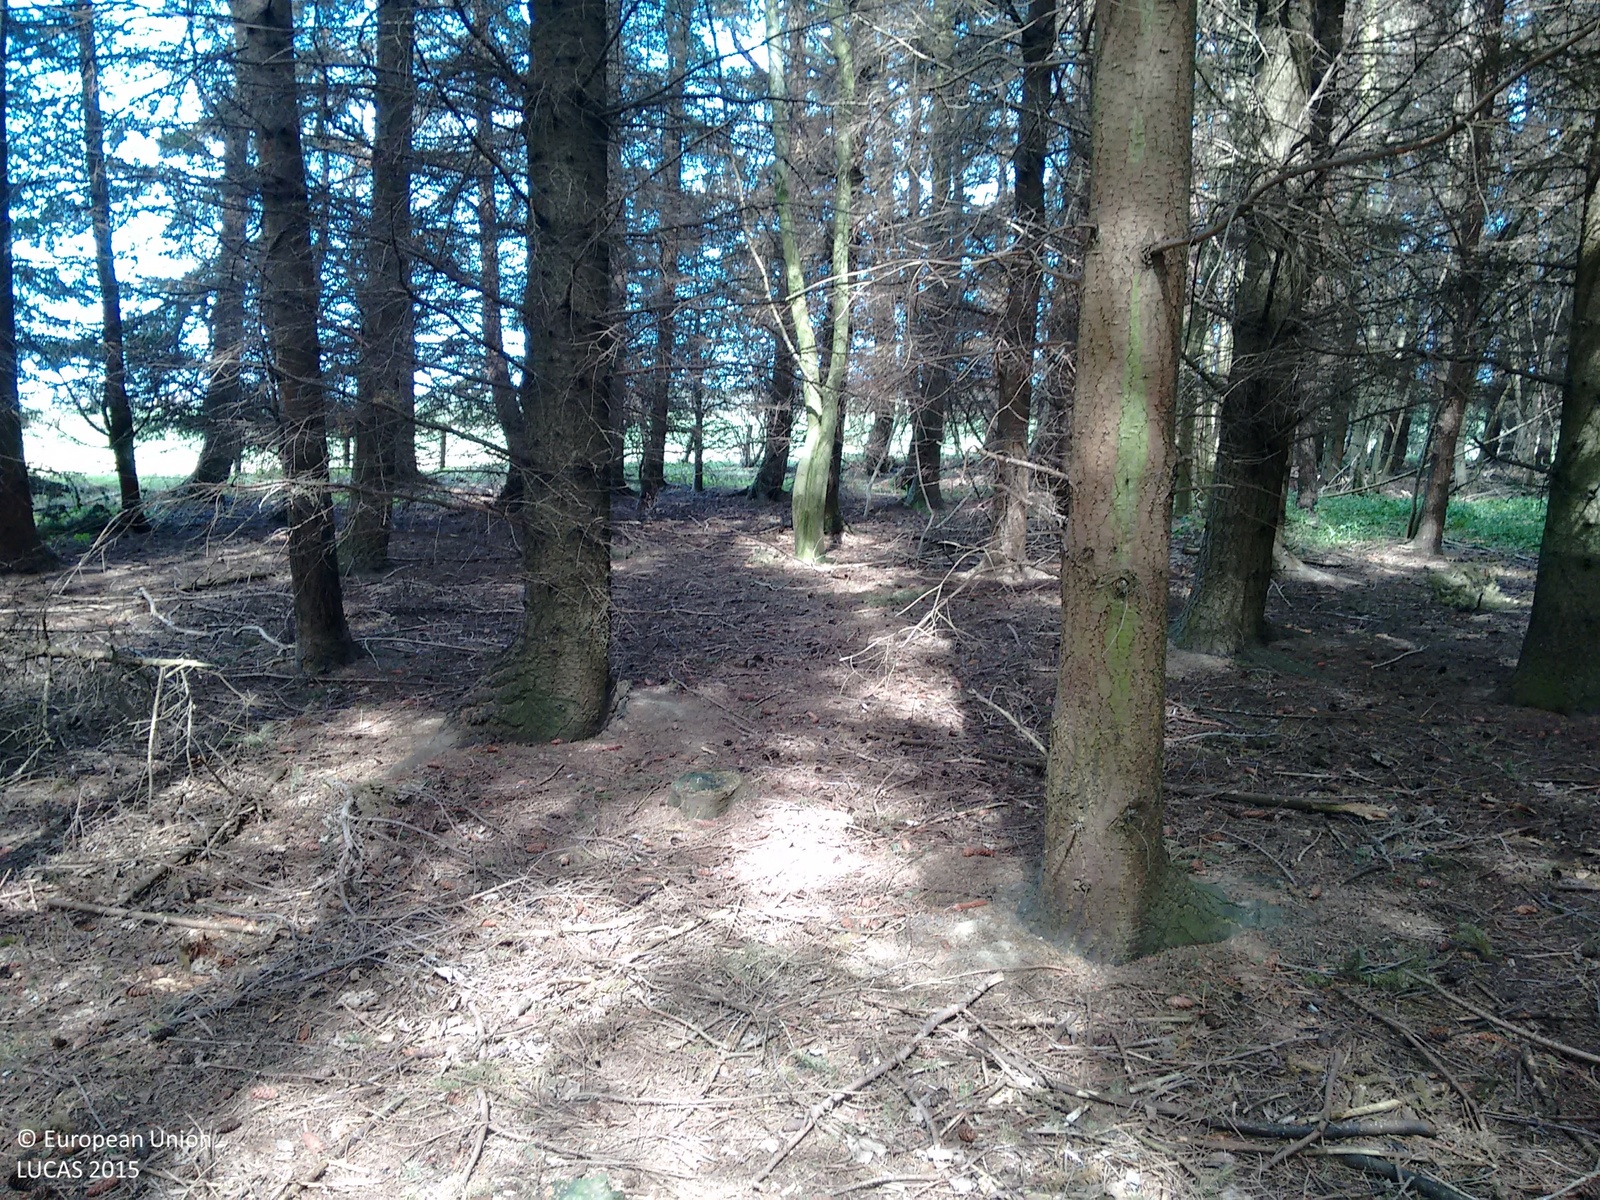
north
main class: Woodland
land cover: Pine dominated coniferous woodland
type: exotic forest
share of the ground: > 75 %
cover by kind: coniferous forest trees 100 %
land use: Forestry
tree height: > 5 m
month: May
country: GB
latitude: 55.3234
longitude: -1.6959
